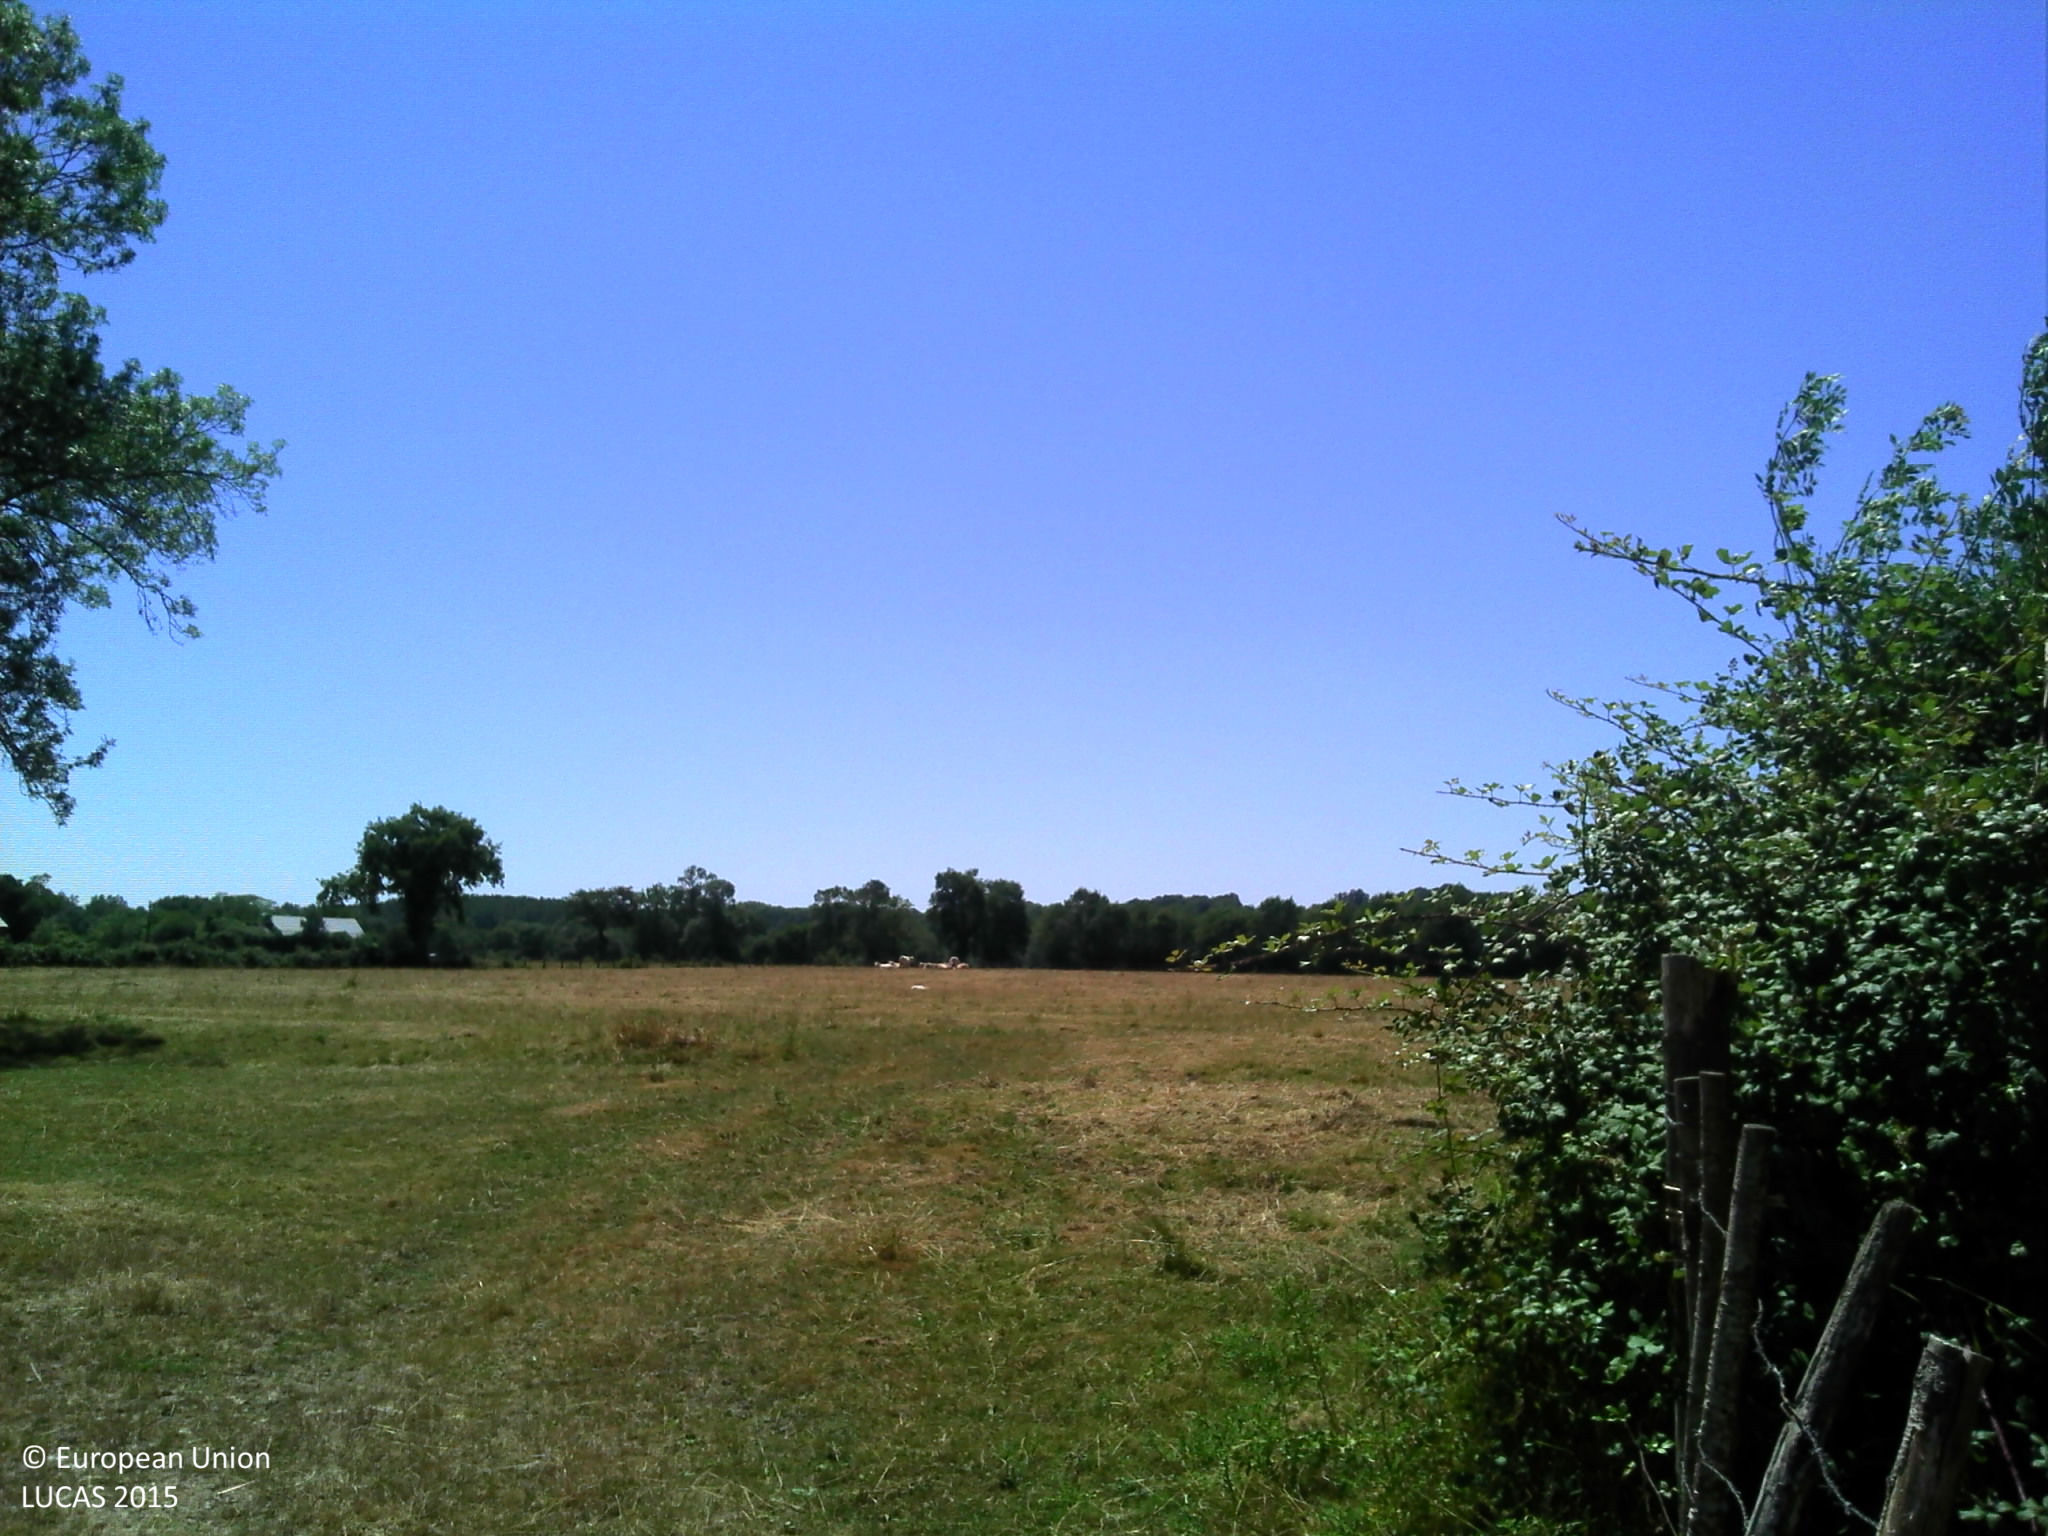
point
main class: Grassland
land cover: Grassland without tree/shrub cover
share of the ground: > 75 %
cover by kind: herbaceous plants 95 %, shrubs 5 %
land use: Agriculture (excluding fallow land and kitchen gardens)
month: July
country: FR
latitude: 47.6675
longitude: 0.2943
